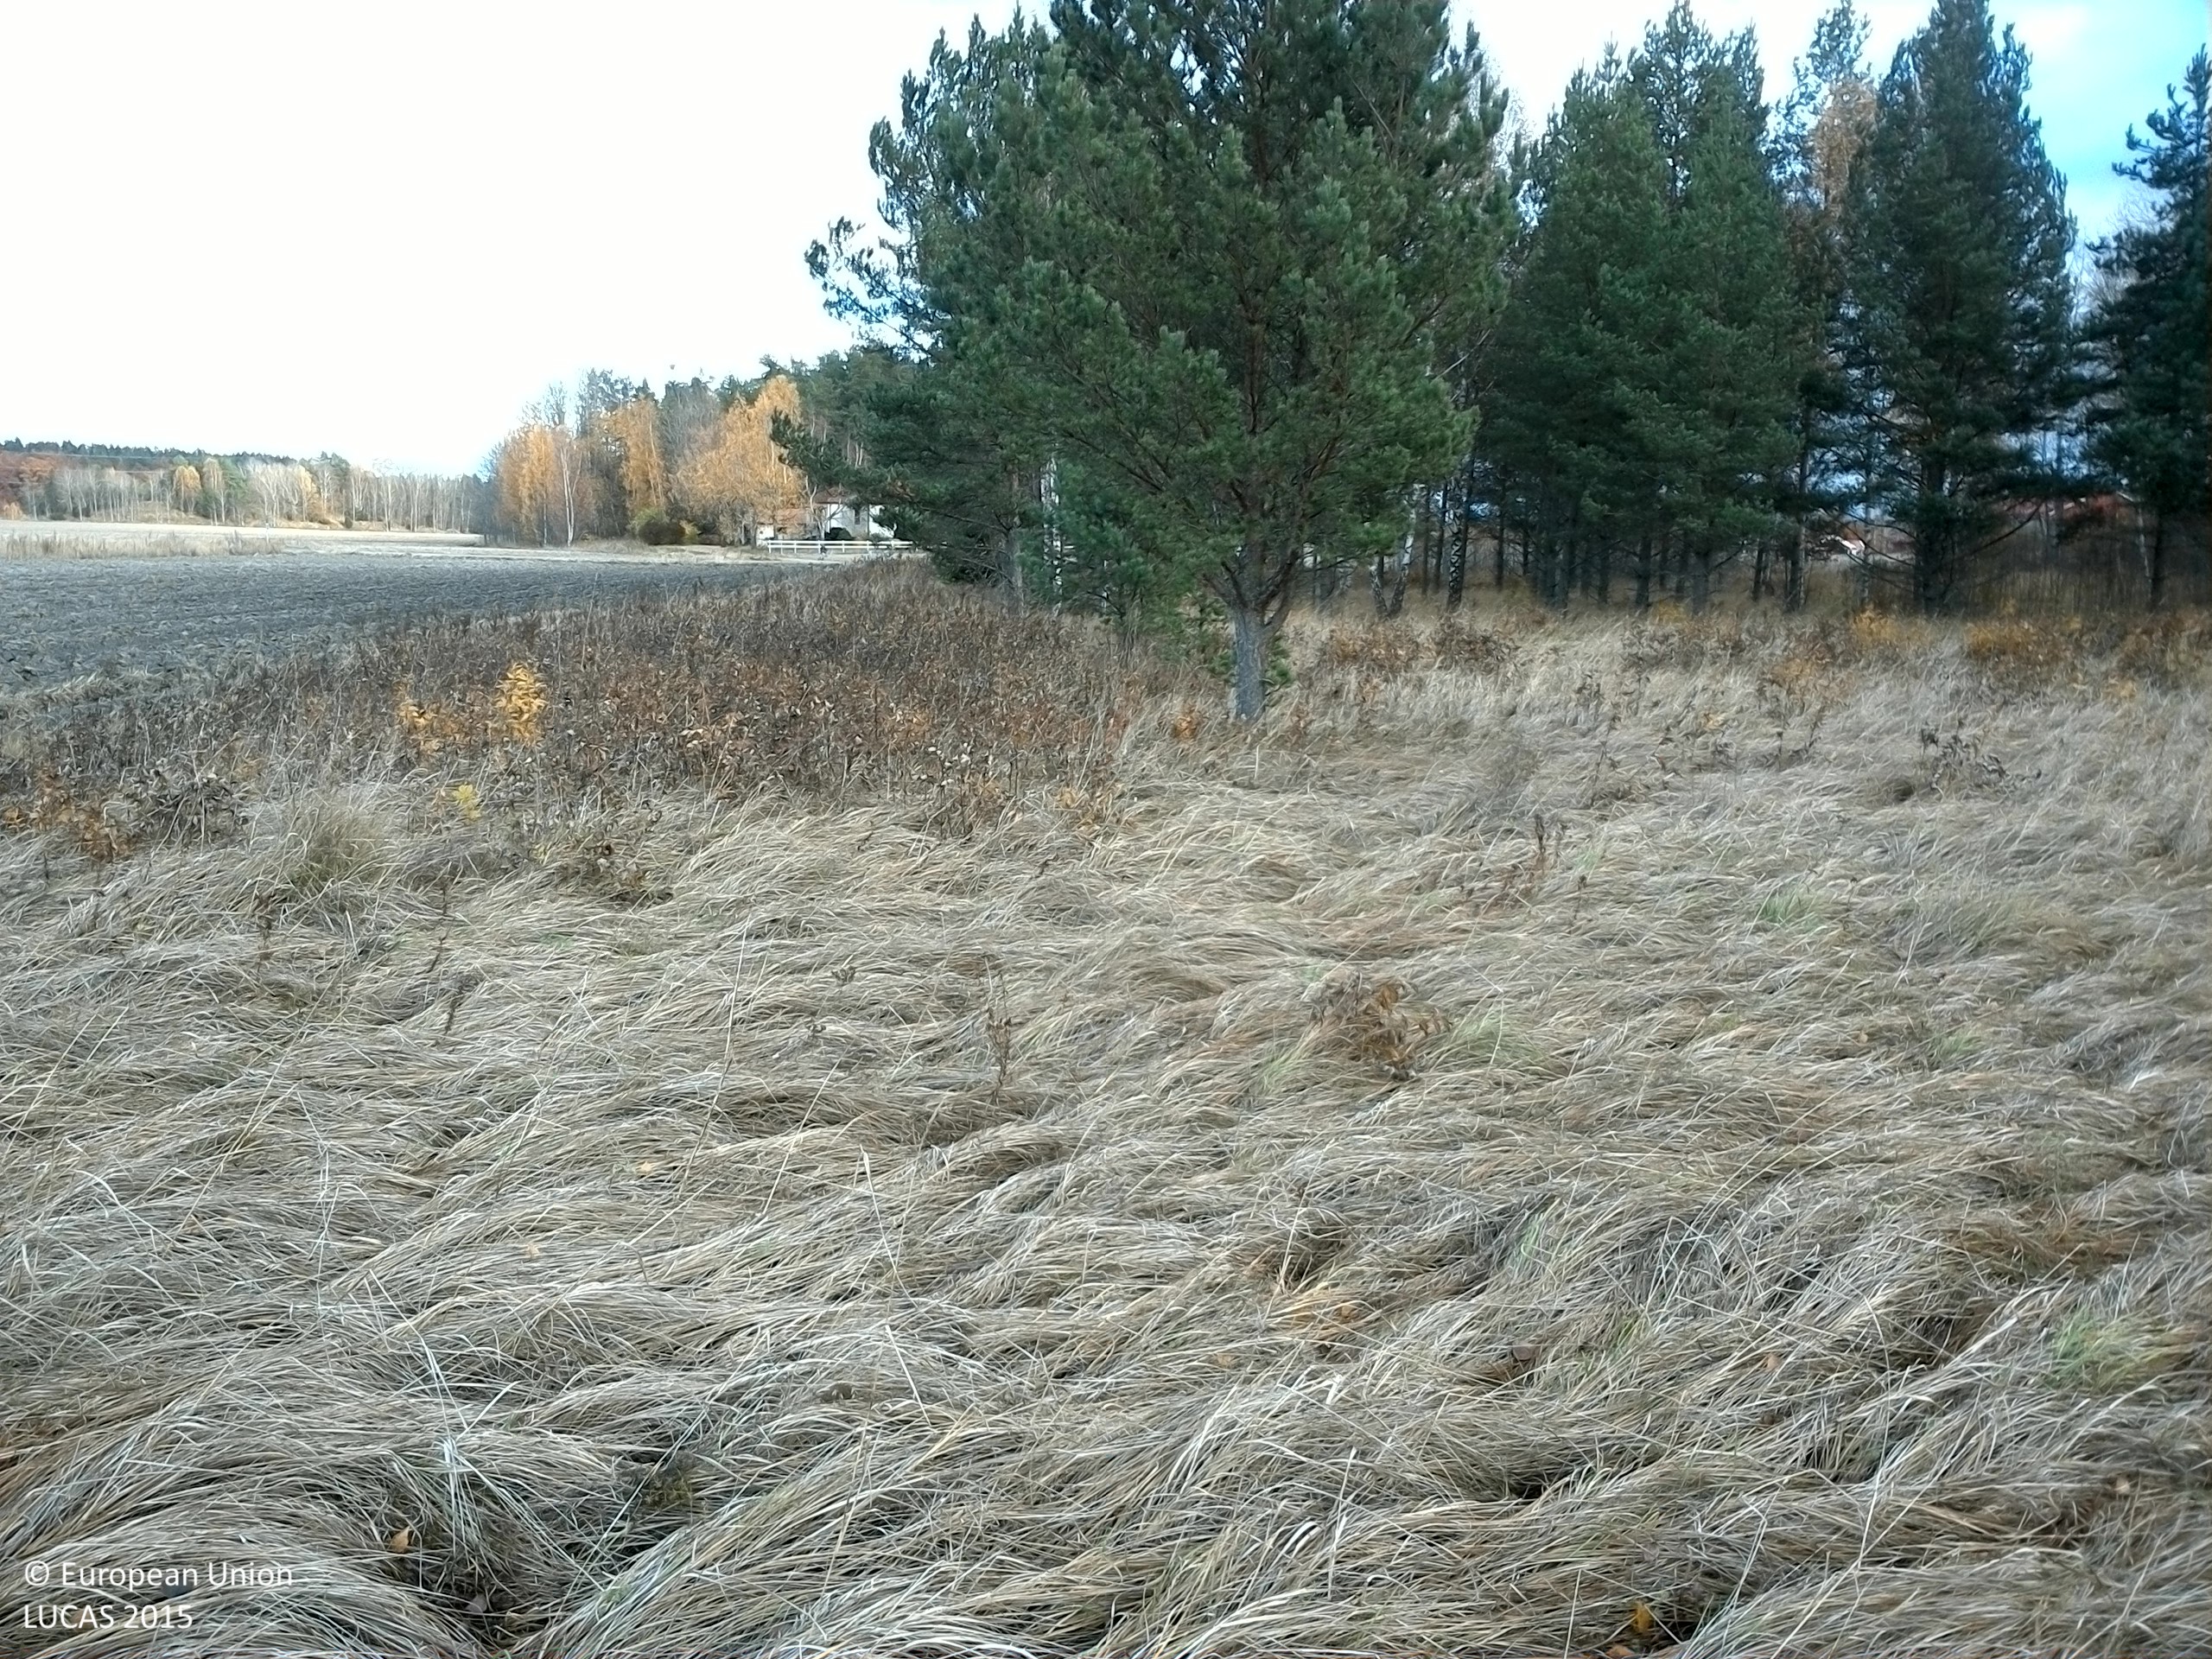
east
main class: Grassland
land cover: Grassland with sparse tree/shrub cover
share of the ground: > 75 %
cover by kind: herbaceous plants 95 %, coniferous forest trees 5 %
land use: Semi-natural and natural areas not in use
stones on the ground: < 10 %
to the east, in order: Grassland with sparse tree/shrub cover; Pine dominated mixed woodland; Paved roads, cycling and walking lanes; Grass margins; Other bare soil; Grass margins; Fences; Artificial constructions in urban areas; Fences; Grass margins; Other bare soil; Pine dominated mixed woodland
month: October
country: SE
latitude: 59.3777
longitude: 16.5582
